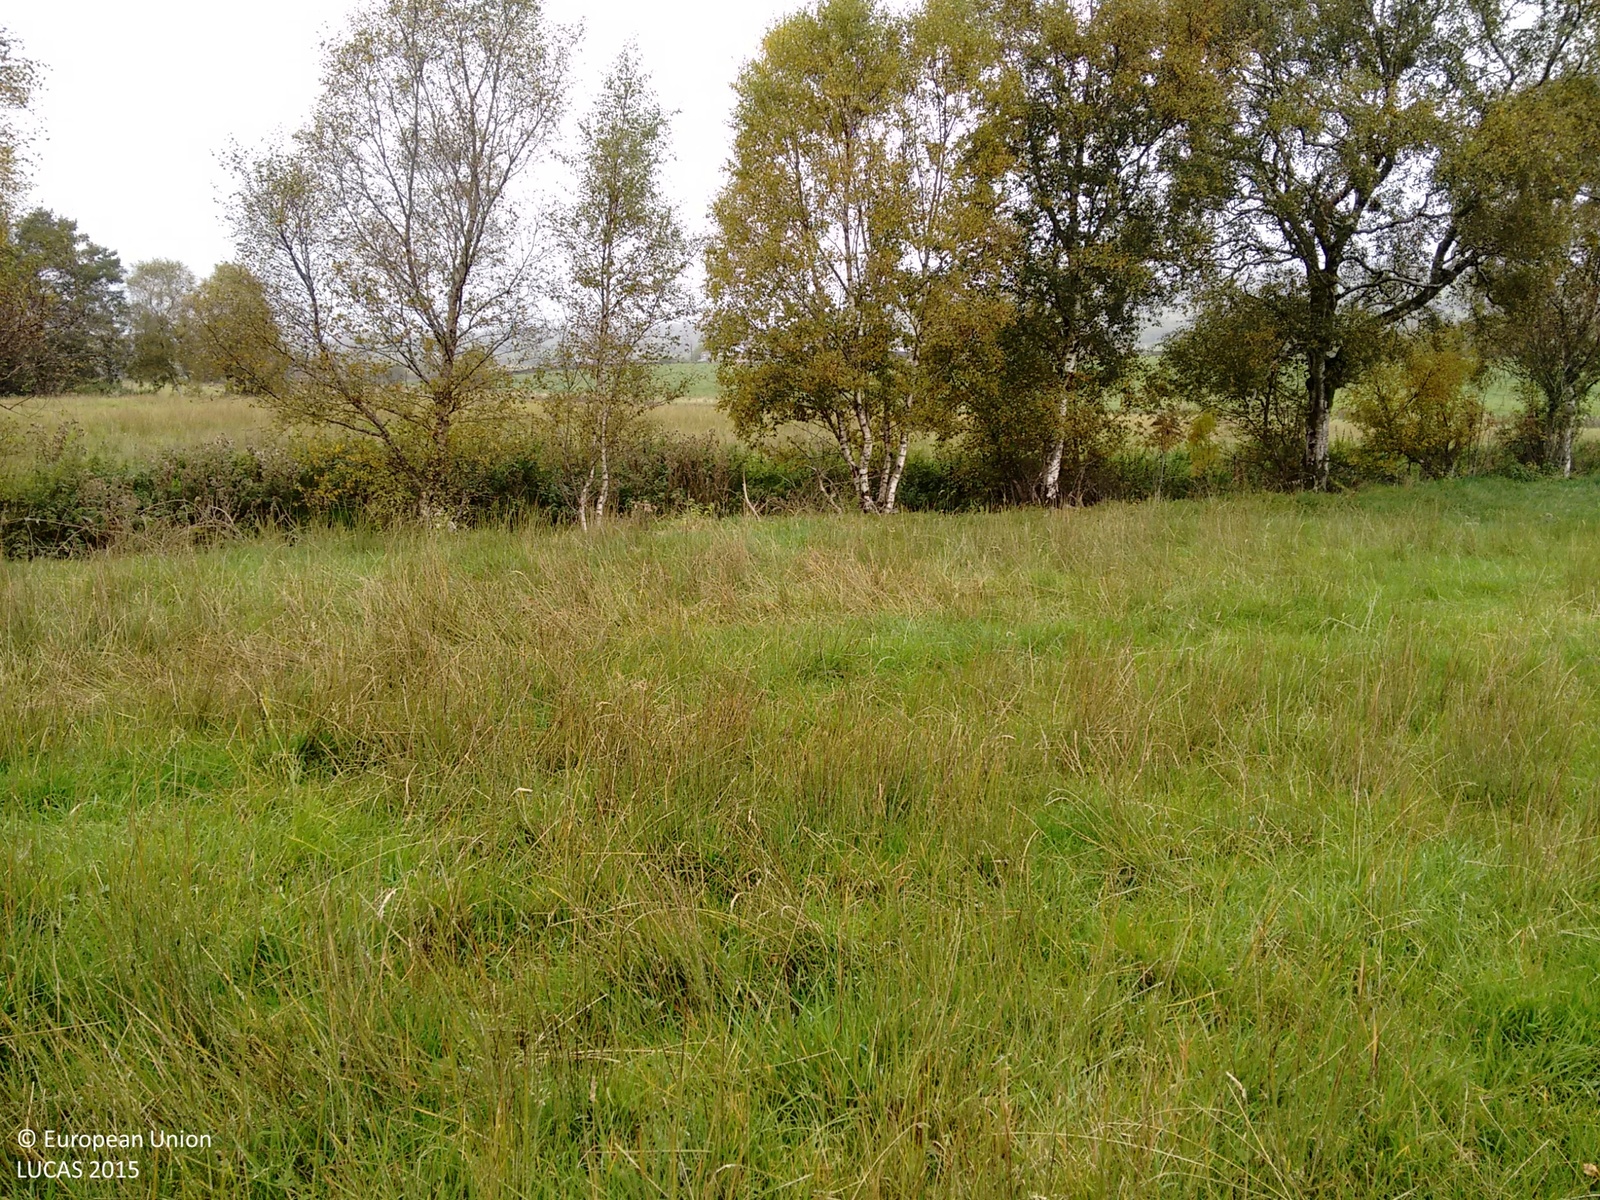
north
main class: Grassland
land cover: Grassland without tree/shrub cover
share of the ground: > 75 %
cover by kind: herbaceous plants 100 %
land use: Agriculture (excluding fallow land and kitchen gardens)
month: October
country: GB
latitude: 54.6479
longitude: -7.4327
